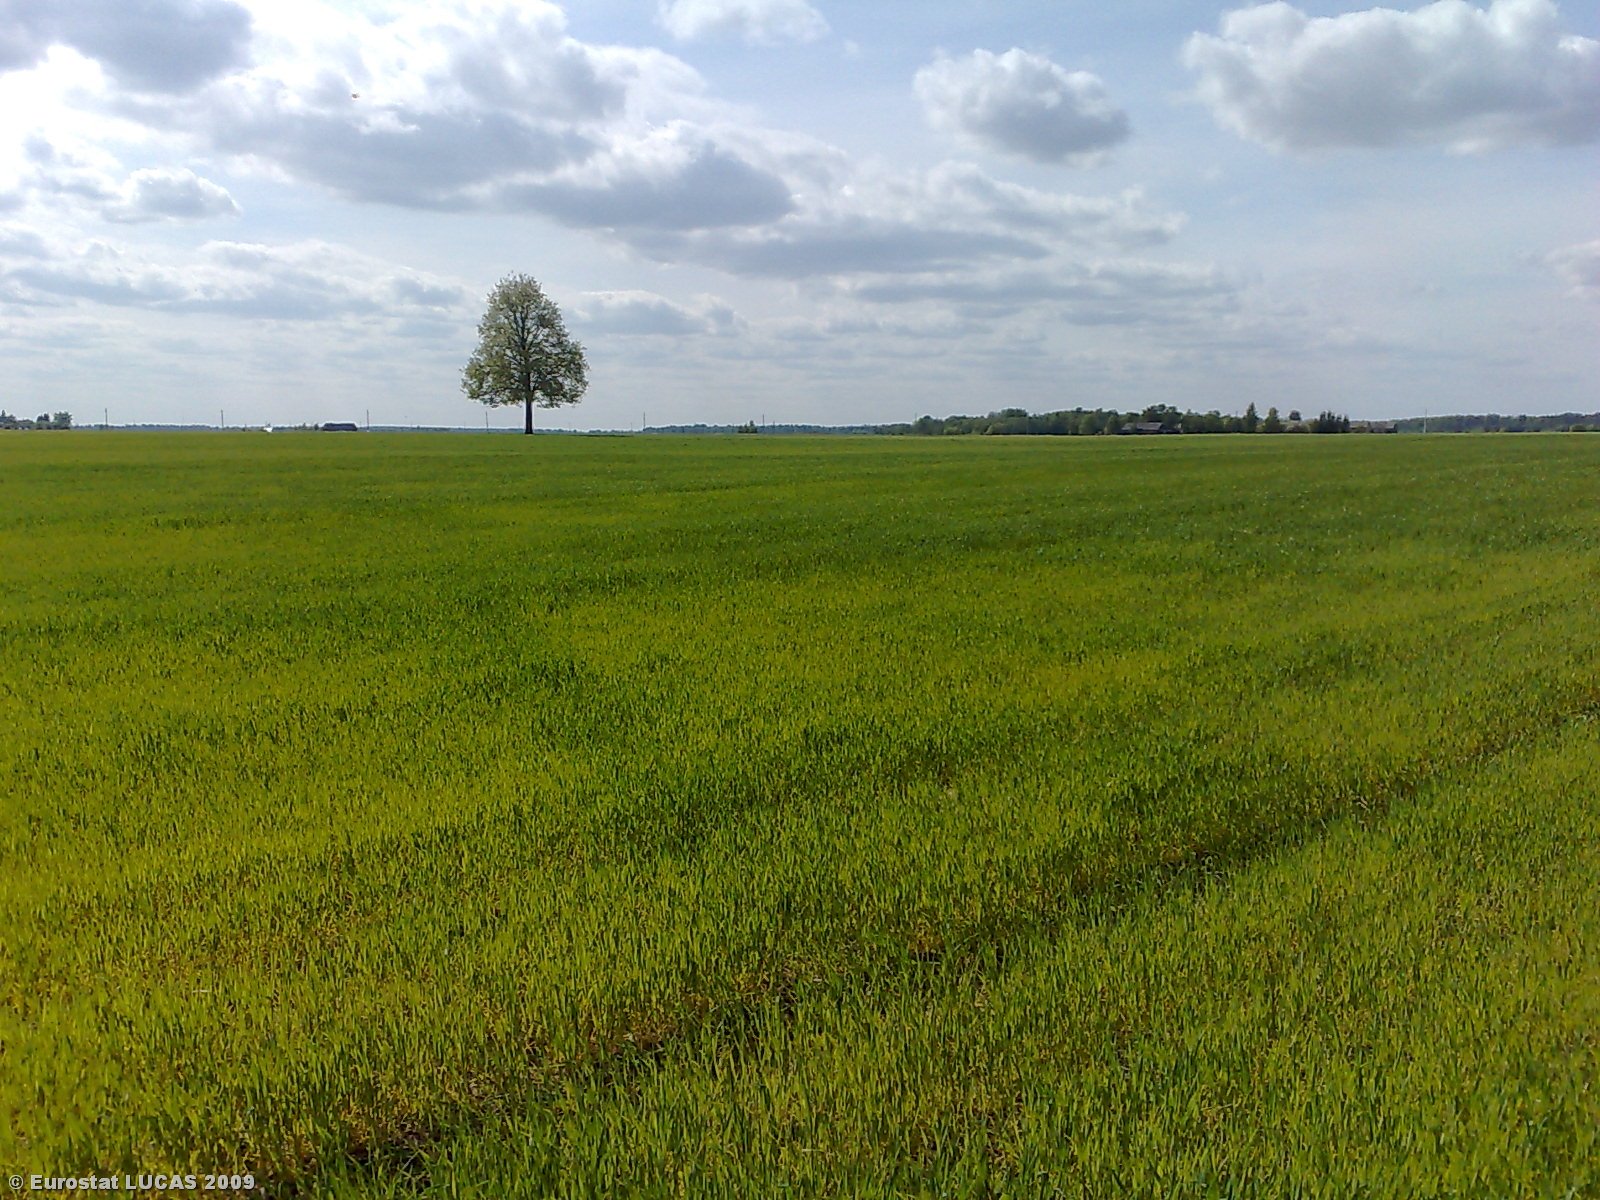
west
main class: Cropland
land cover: Common wheat
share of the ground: > 75 %
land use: Agriculture (excluding fallow land and kitchen gardens)
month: May
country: LT
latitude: 55.7829
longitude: 23.8132
